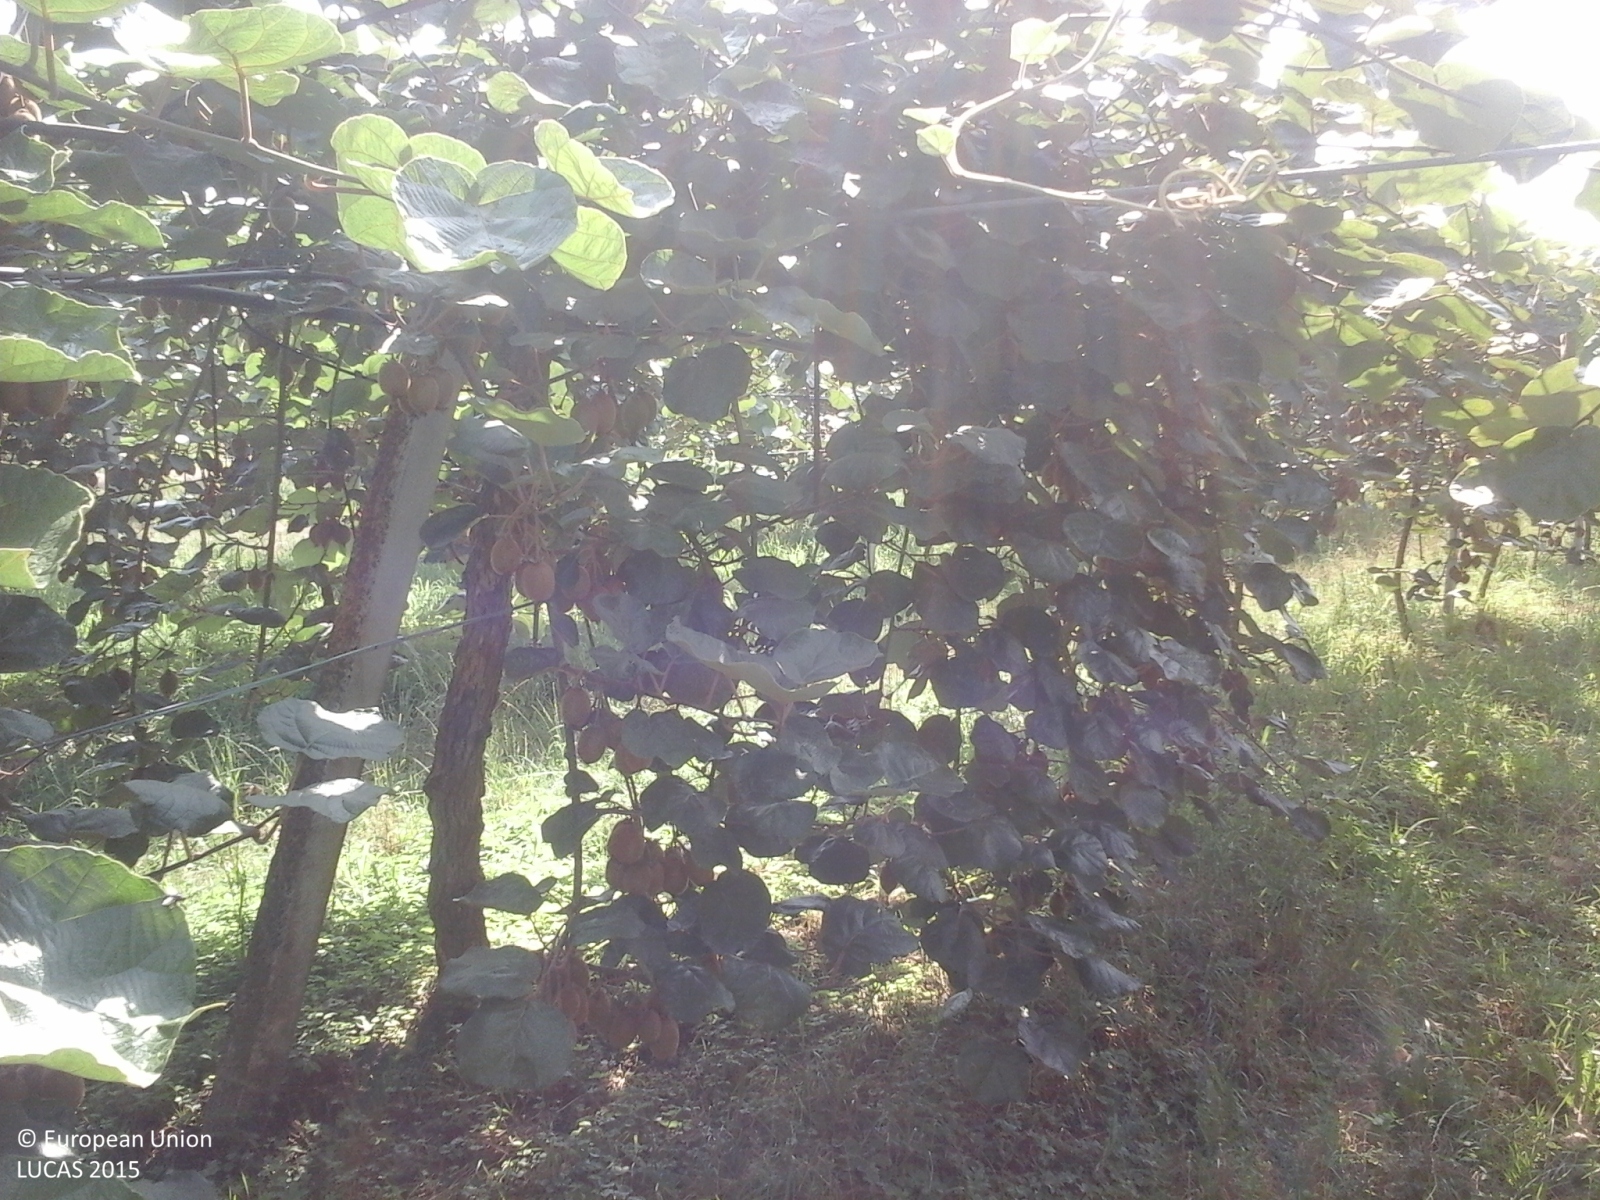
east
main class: Cropland
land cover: Other fruit trees and berries
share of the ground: > 75 %
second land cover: Grassland without tree/shrub cover
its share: > 75 %
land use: Agriculture (excluding fallow land and kitchen gardens)
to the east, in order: Other fruit trees and berries; Grassland without tree/shrub cover; Tracks; Maize; Electric lines; Maize
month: July
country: IT
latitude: 45.3211
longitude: 10.8023
